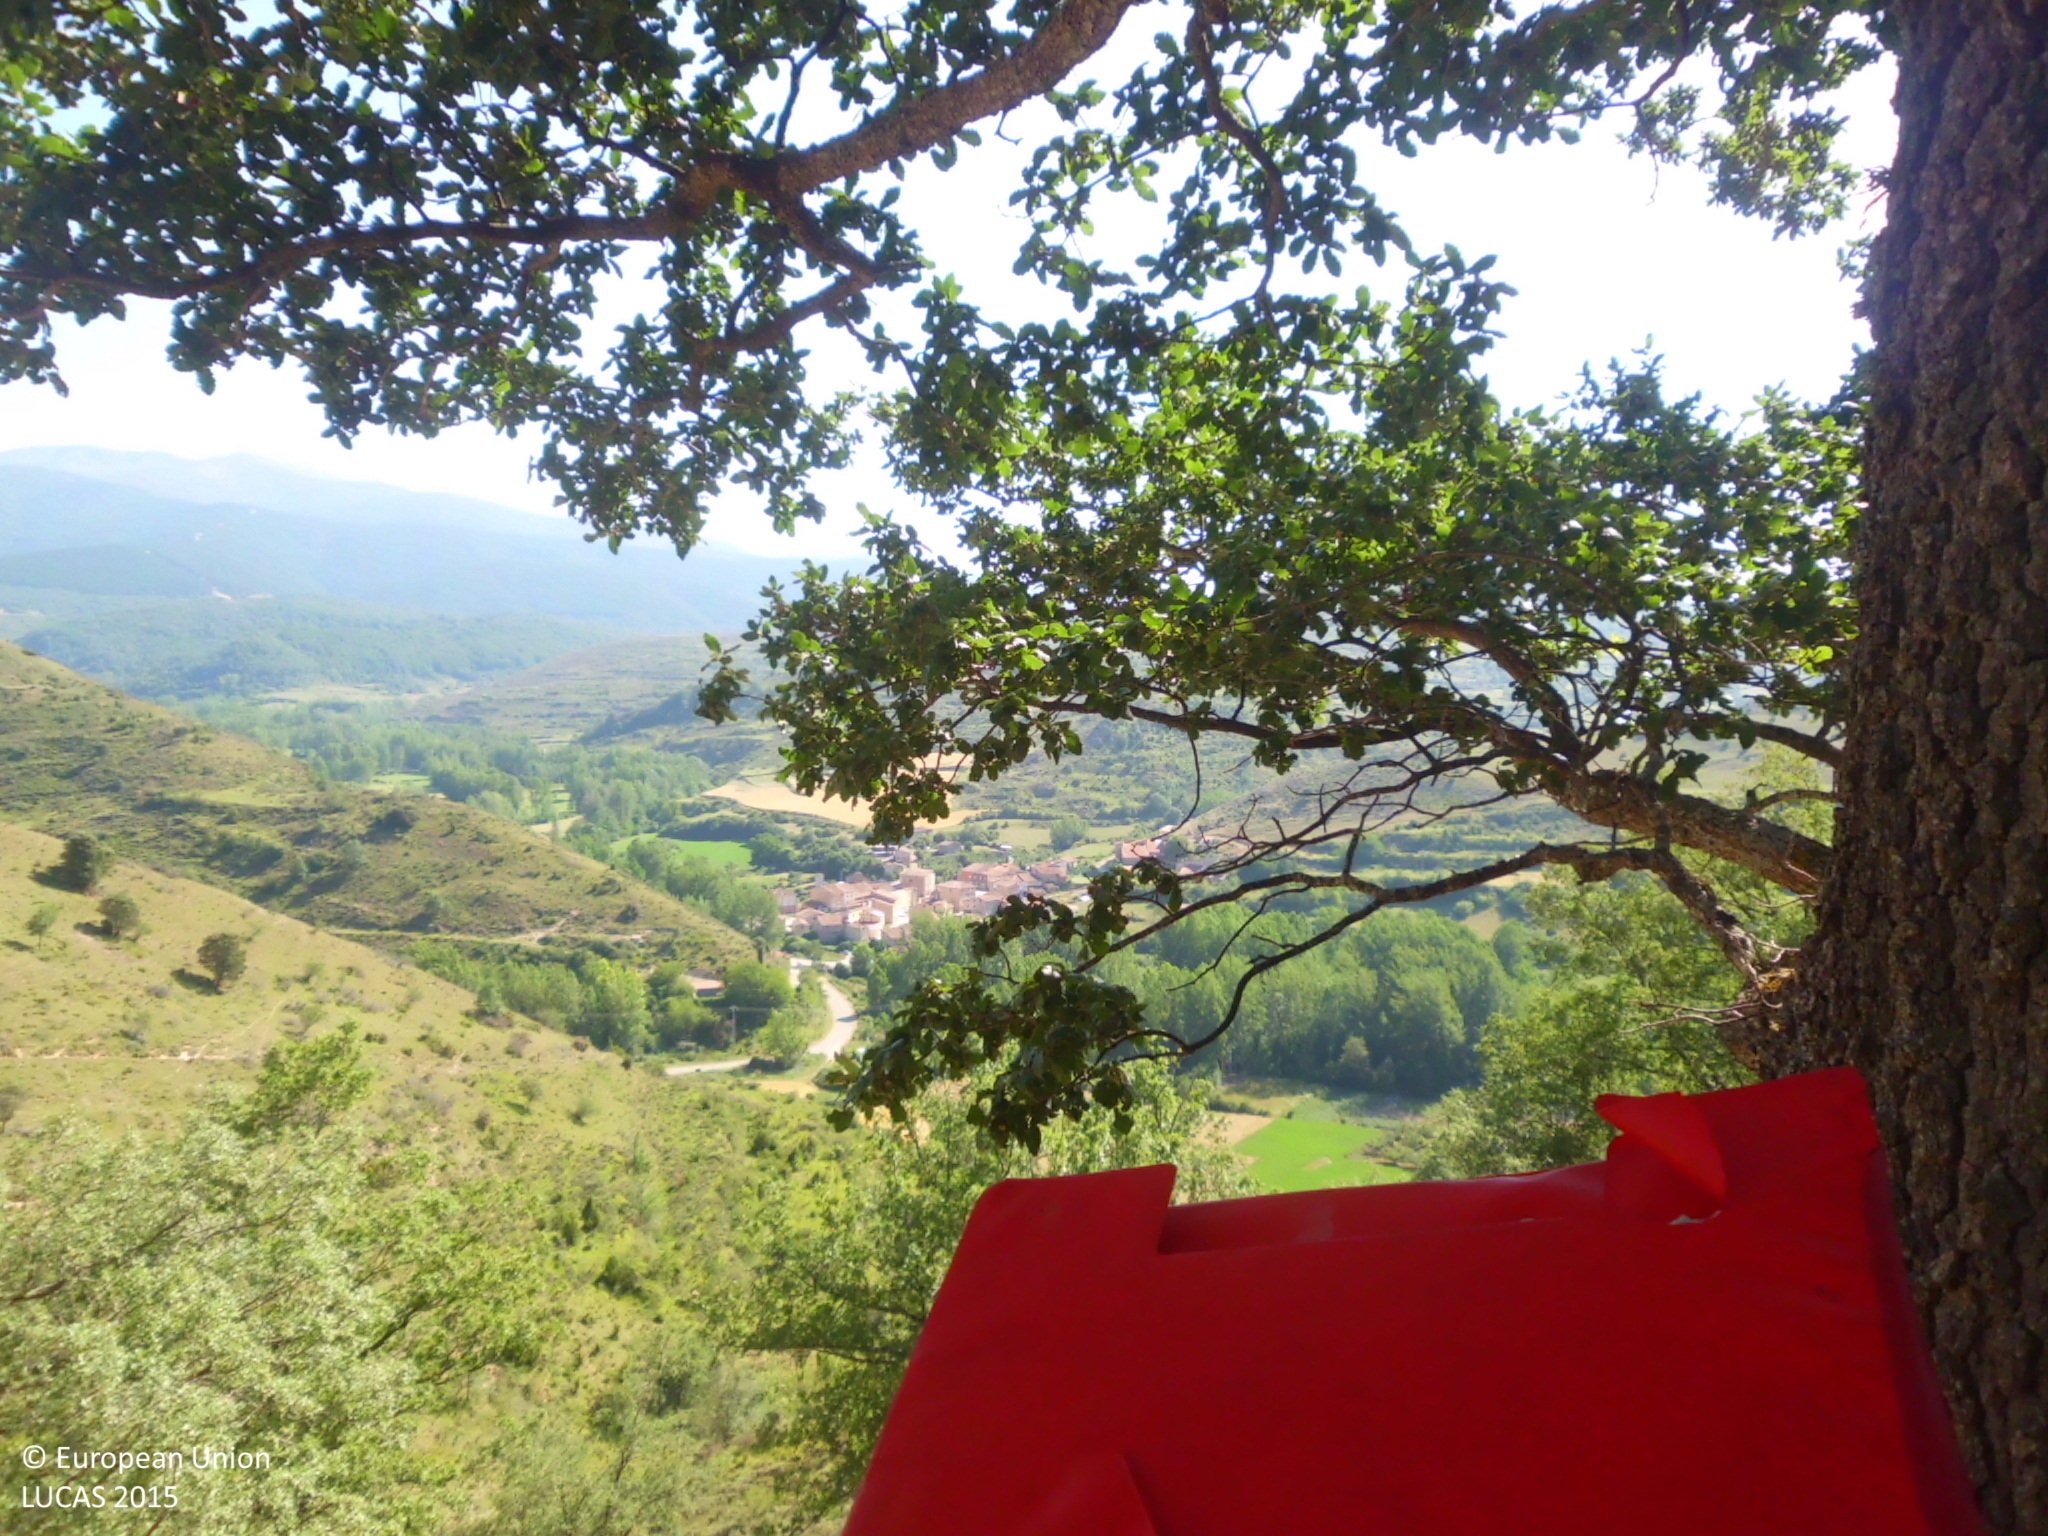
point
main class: Woodland
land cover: Broadleaved woodland
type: acidophilous oak and oak-birch forest
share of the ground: 25 - 50 %
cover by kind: unconsolidated bare surface 35 %, broadleaved forest trees 25 %, herbaceous plants 25 %, consolidated bare surface 10 %, shrubs 5 %
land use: Semi-natural and natural areas not in use
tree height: > 5 m
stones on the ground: 25 - 50 %
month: July
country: ES
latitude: 42.3314
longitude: -3.2210
